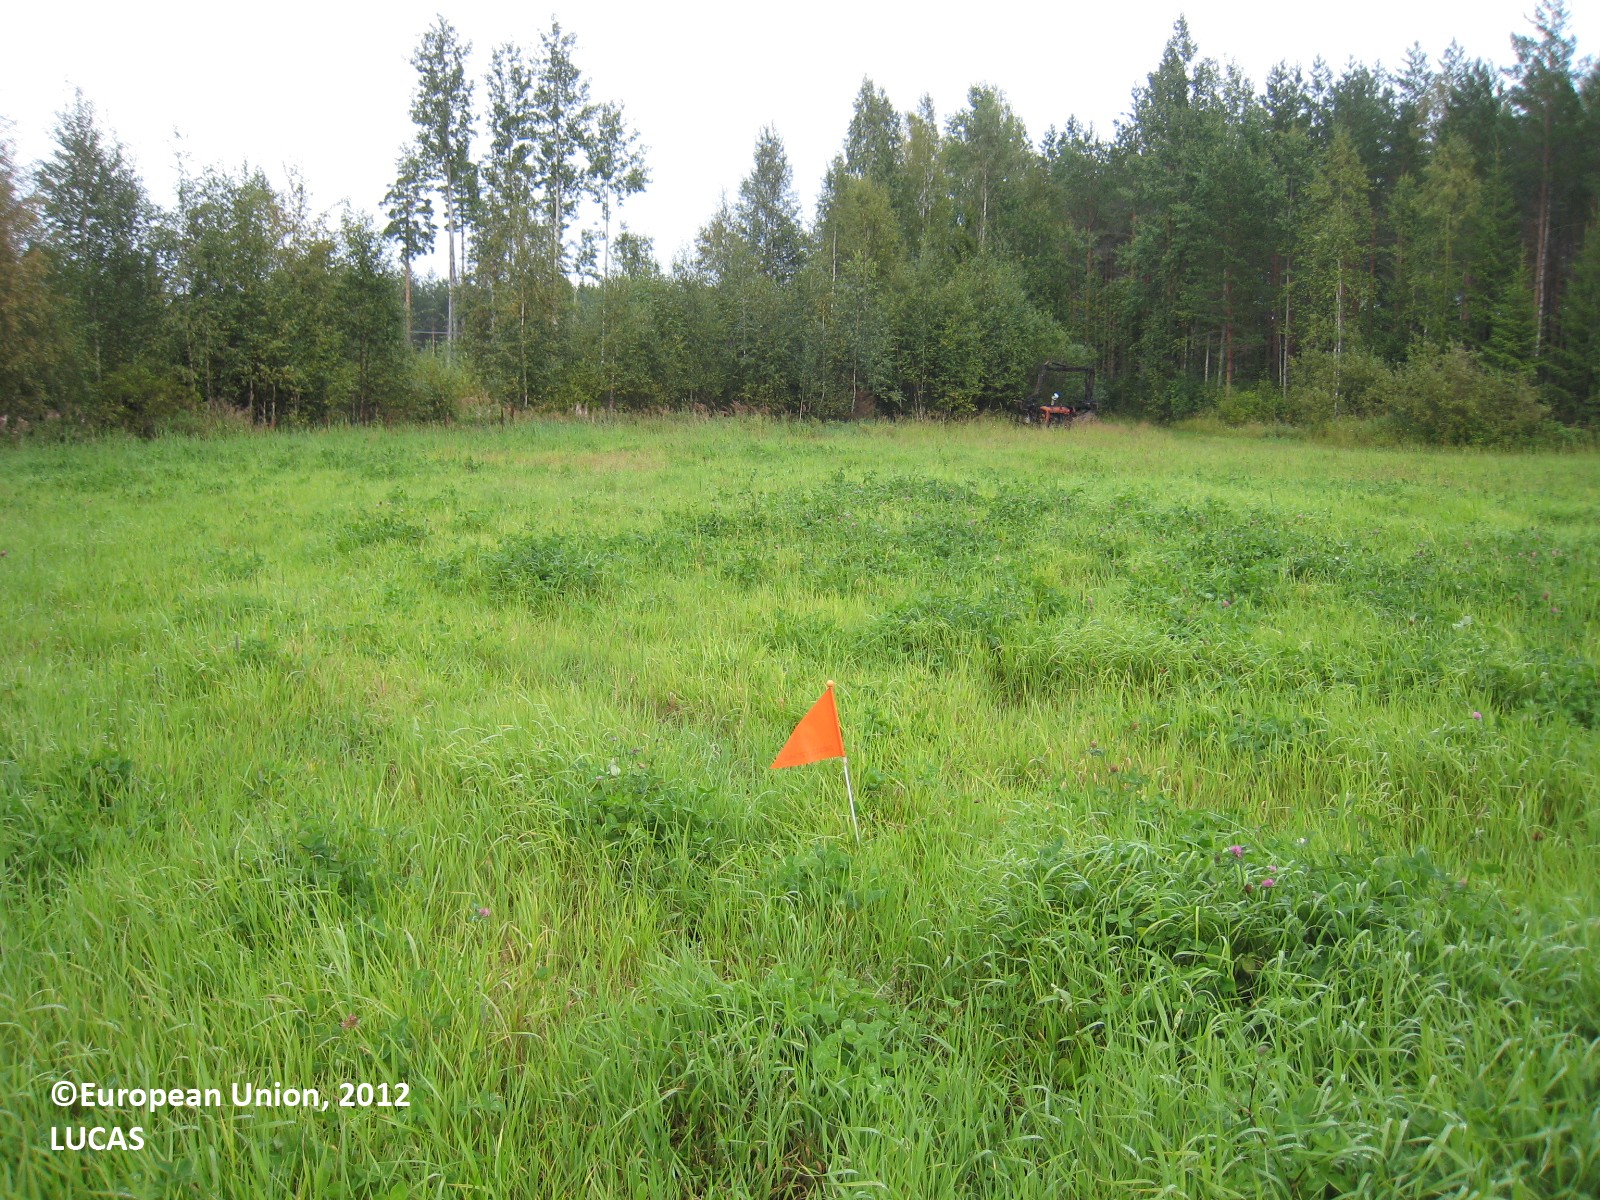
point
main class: Cropland
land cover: Temporary grasslands
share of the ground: > 75 %
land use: Agriculture (excluding fallow land and kitchen gardens)
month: August
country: FI
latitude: 61.8775
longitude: 26.1664
